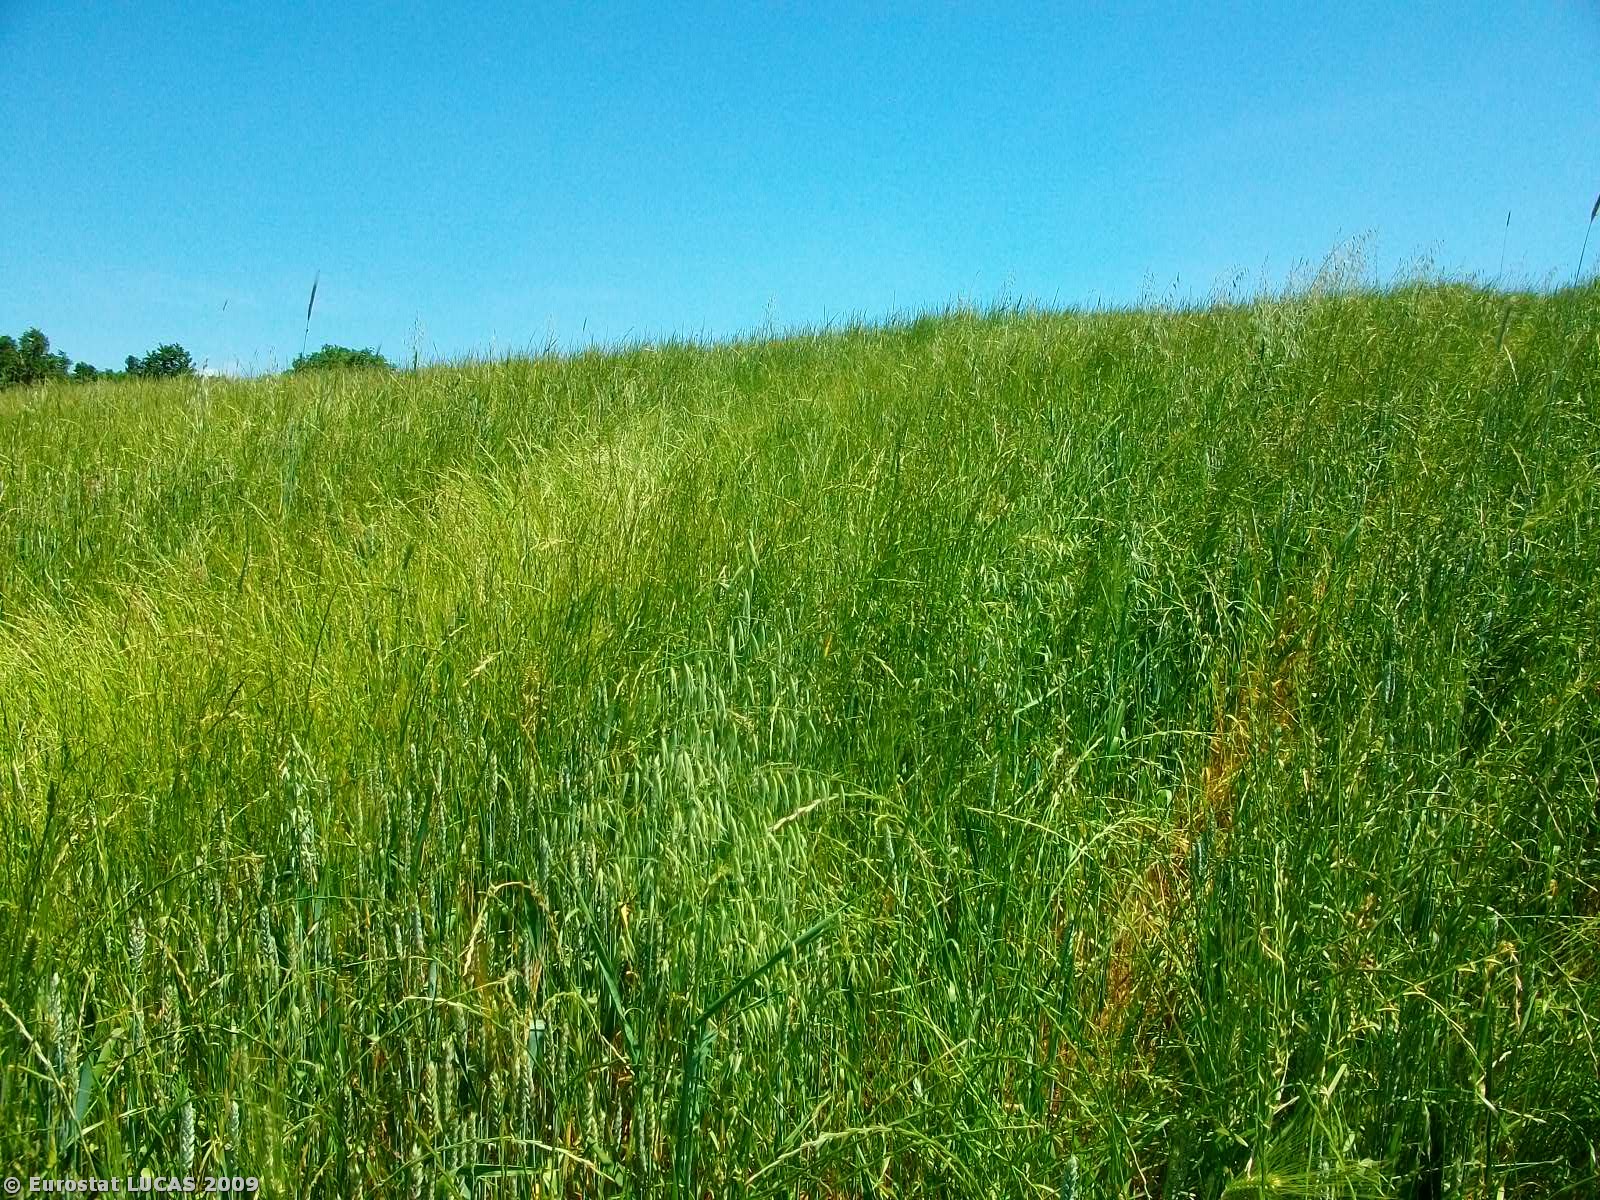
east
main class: Cropland
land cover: Common wheat
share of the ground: > 75 %
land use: Agriculture (excluding fallow land and kitchen gardens)
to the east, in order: Common wheat; Tracks; Common wheat
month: May
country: GR
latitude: 39.8613
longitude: 21.6640
